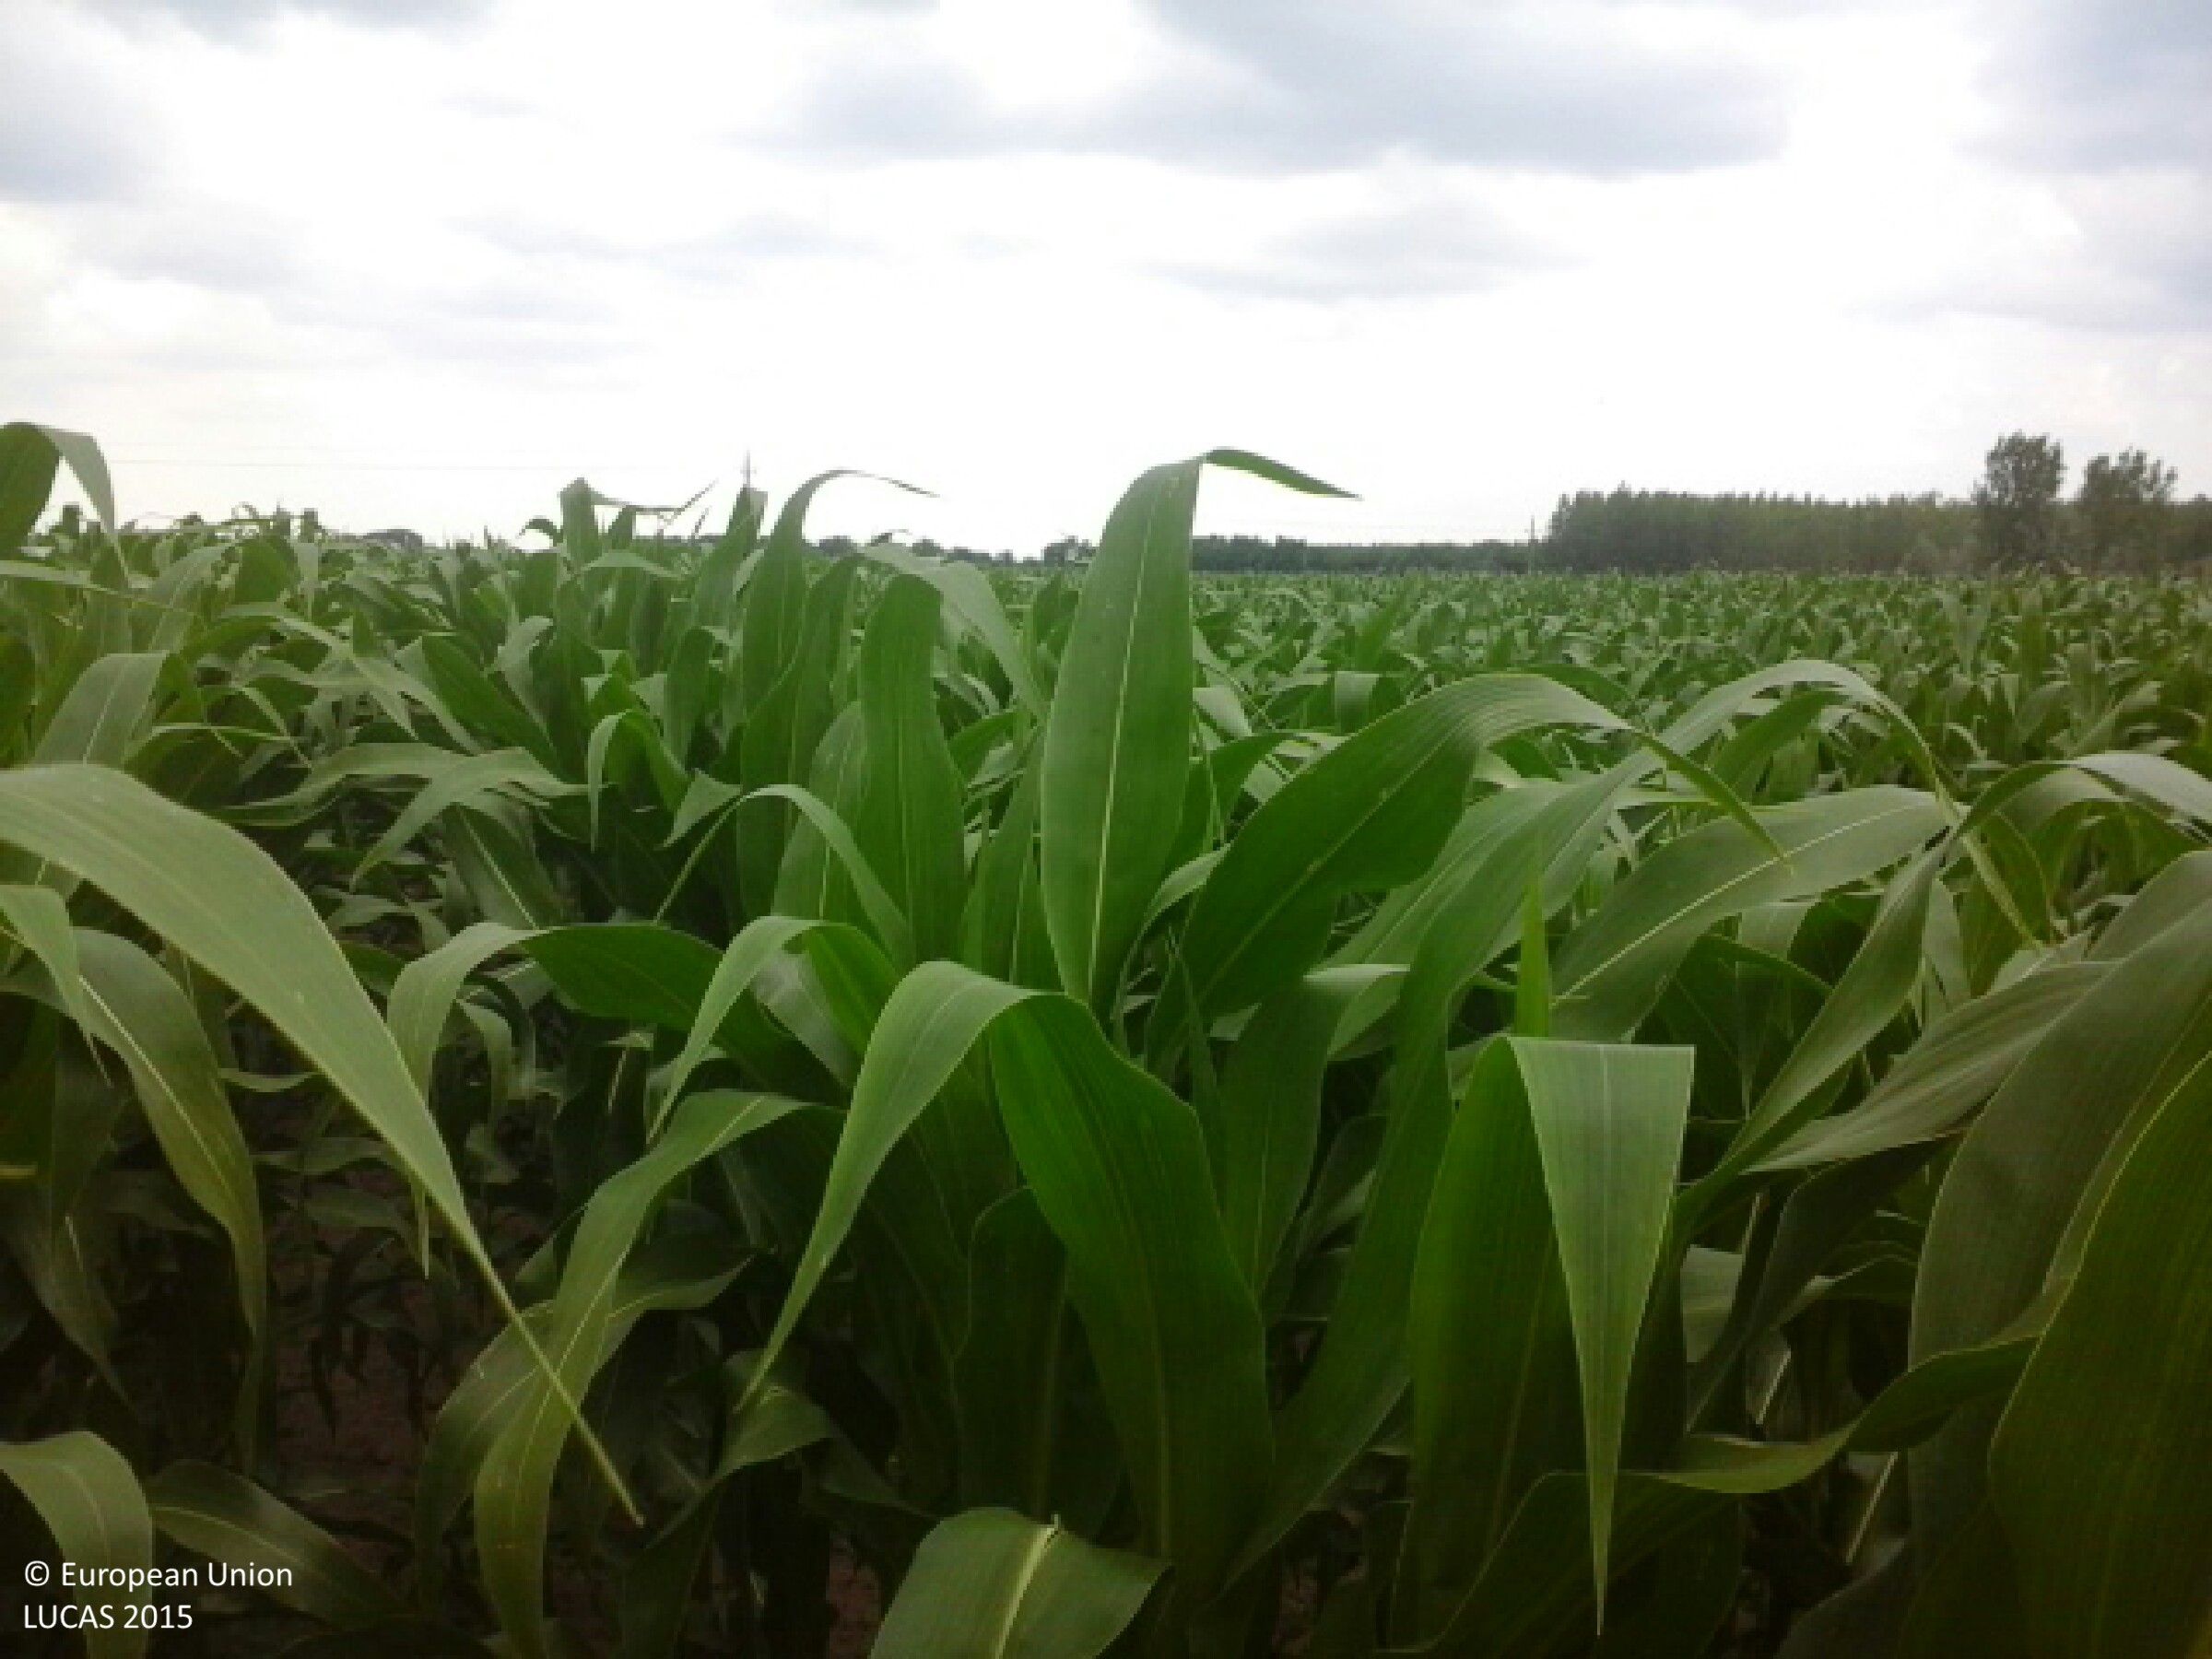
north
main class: Cropland
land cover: Maize
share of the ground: > 75 %
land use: Agriculture (excluding fallow land and kitchen gardens)
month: June
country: HU
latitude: 48.1324
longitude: 21.9707
